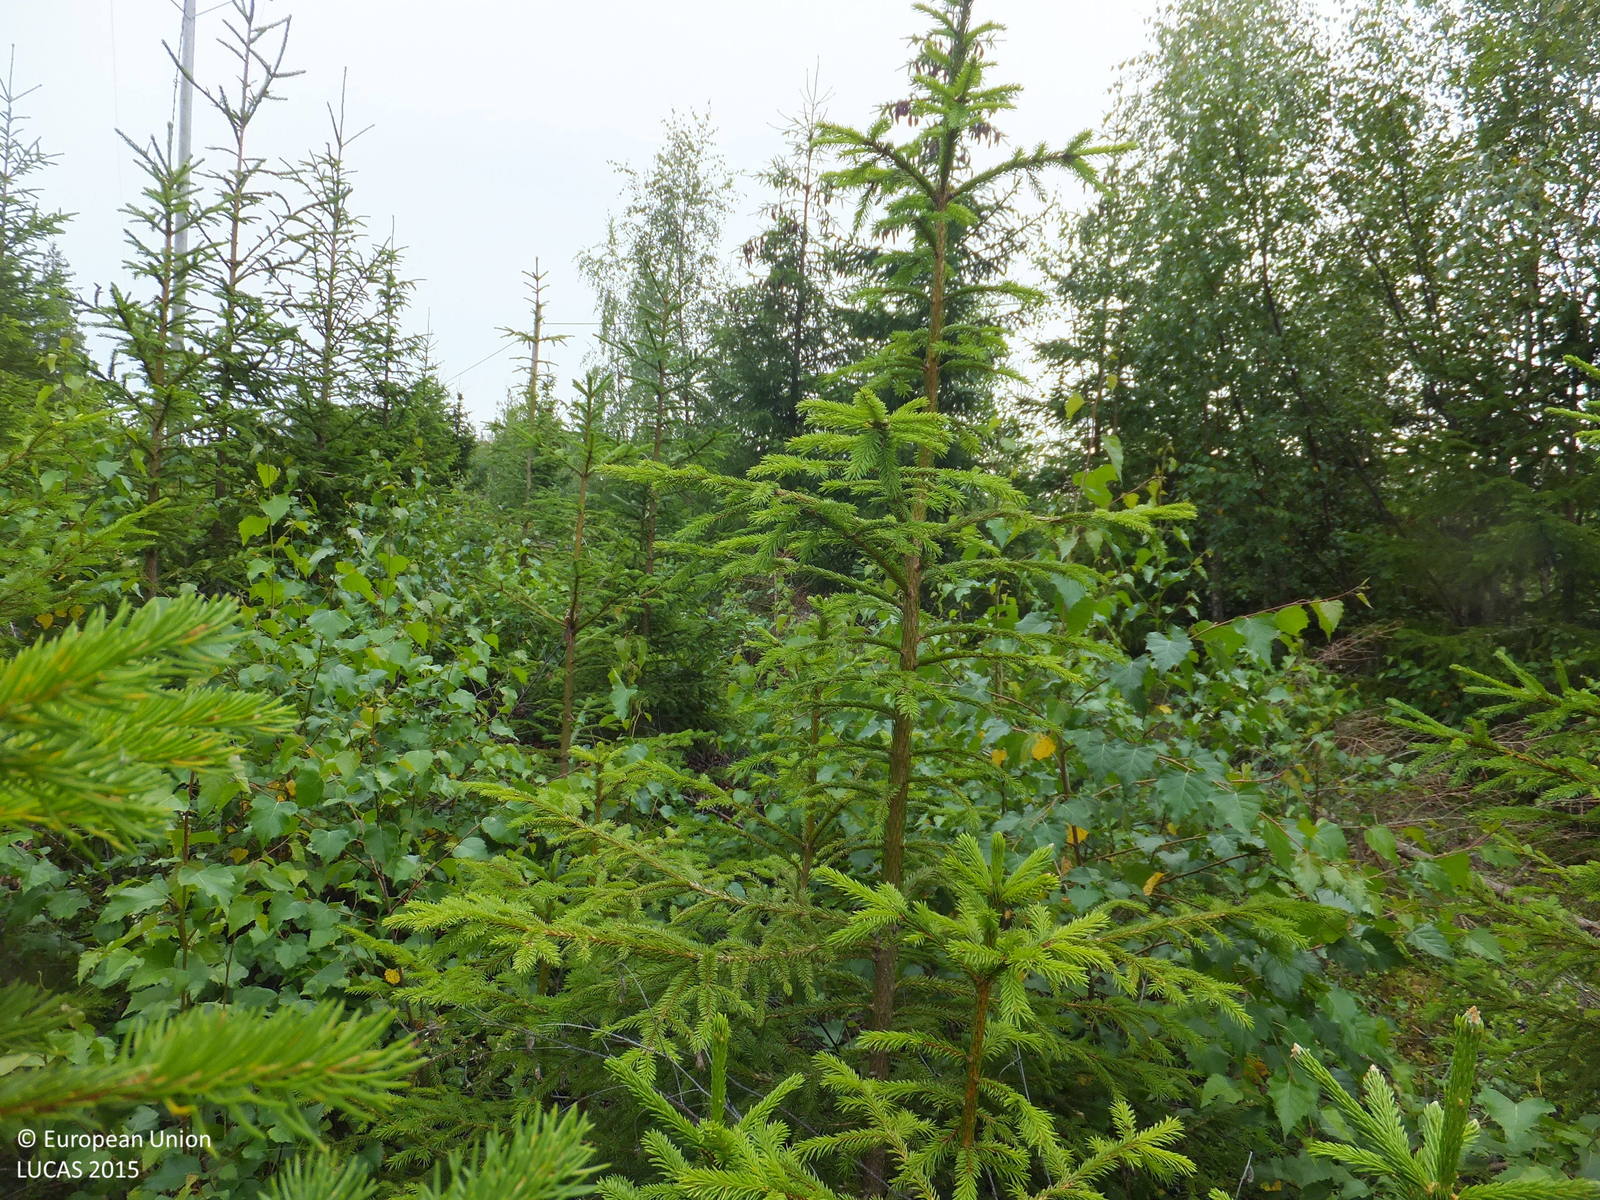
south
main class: Woodland
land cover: Spruce dominated mixed woodland
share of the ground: 25 - 50 %
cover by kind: shrubs 40 %, coniferous forest trees 15 %, broadleaved forest trees 15 %, herbaceous plants 10 %, lichens and mosses 10 %, consolidated bare surface 10 %
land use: Forestry
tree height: < 5 m
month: July
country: FI
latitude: 63.2954
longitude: 21.1029
